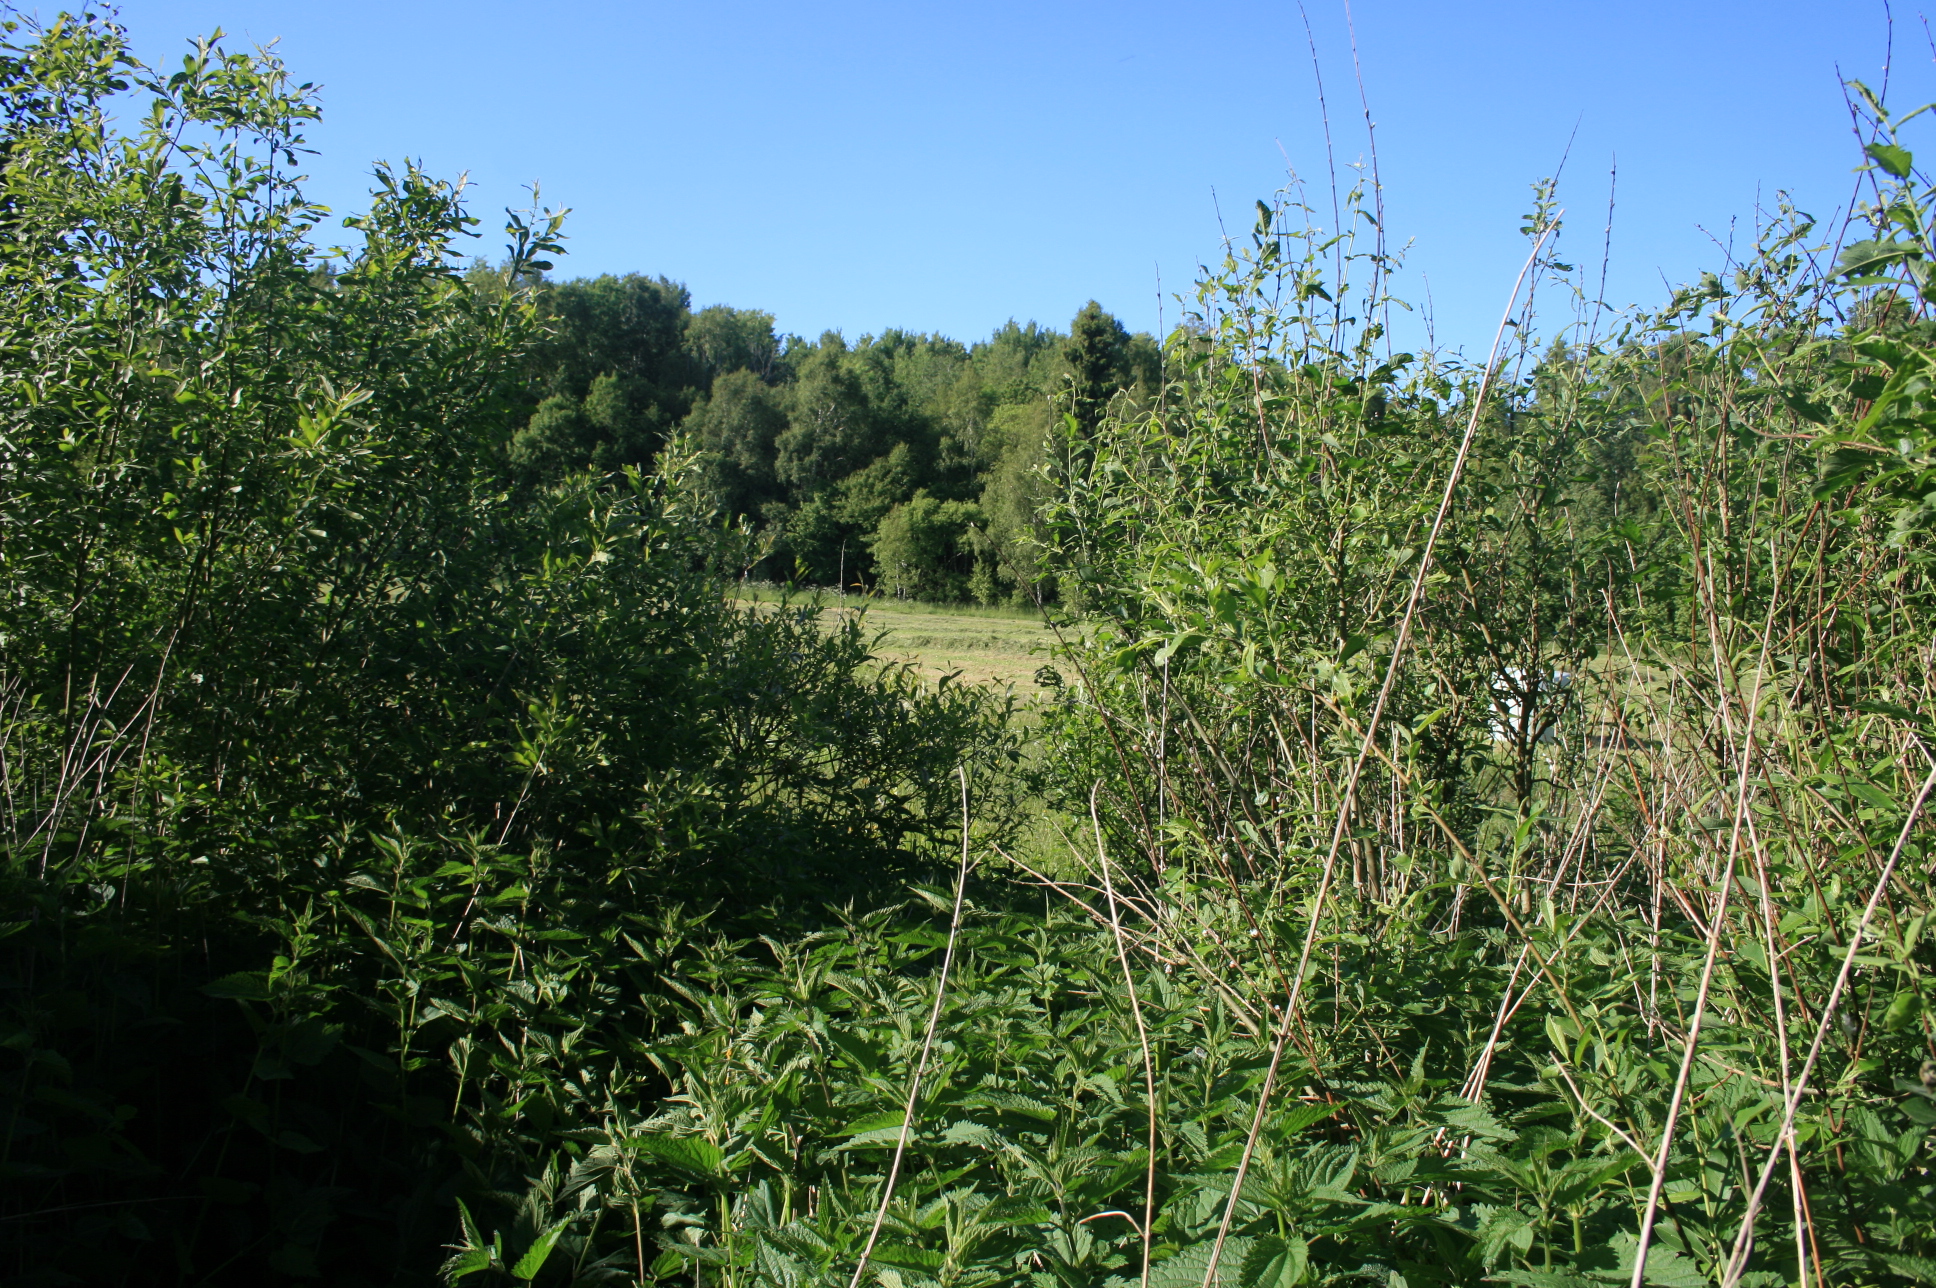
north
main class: Woodland
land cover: Broadleaved woodland
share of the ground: > 75 %
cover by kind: broadleaved forest trees 95 %, herbaceous plants 5 %
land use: Semi-natural and natural areas not in use
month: June
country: LT
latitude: 55.5825
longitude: 22.2239
